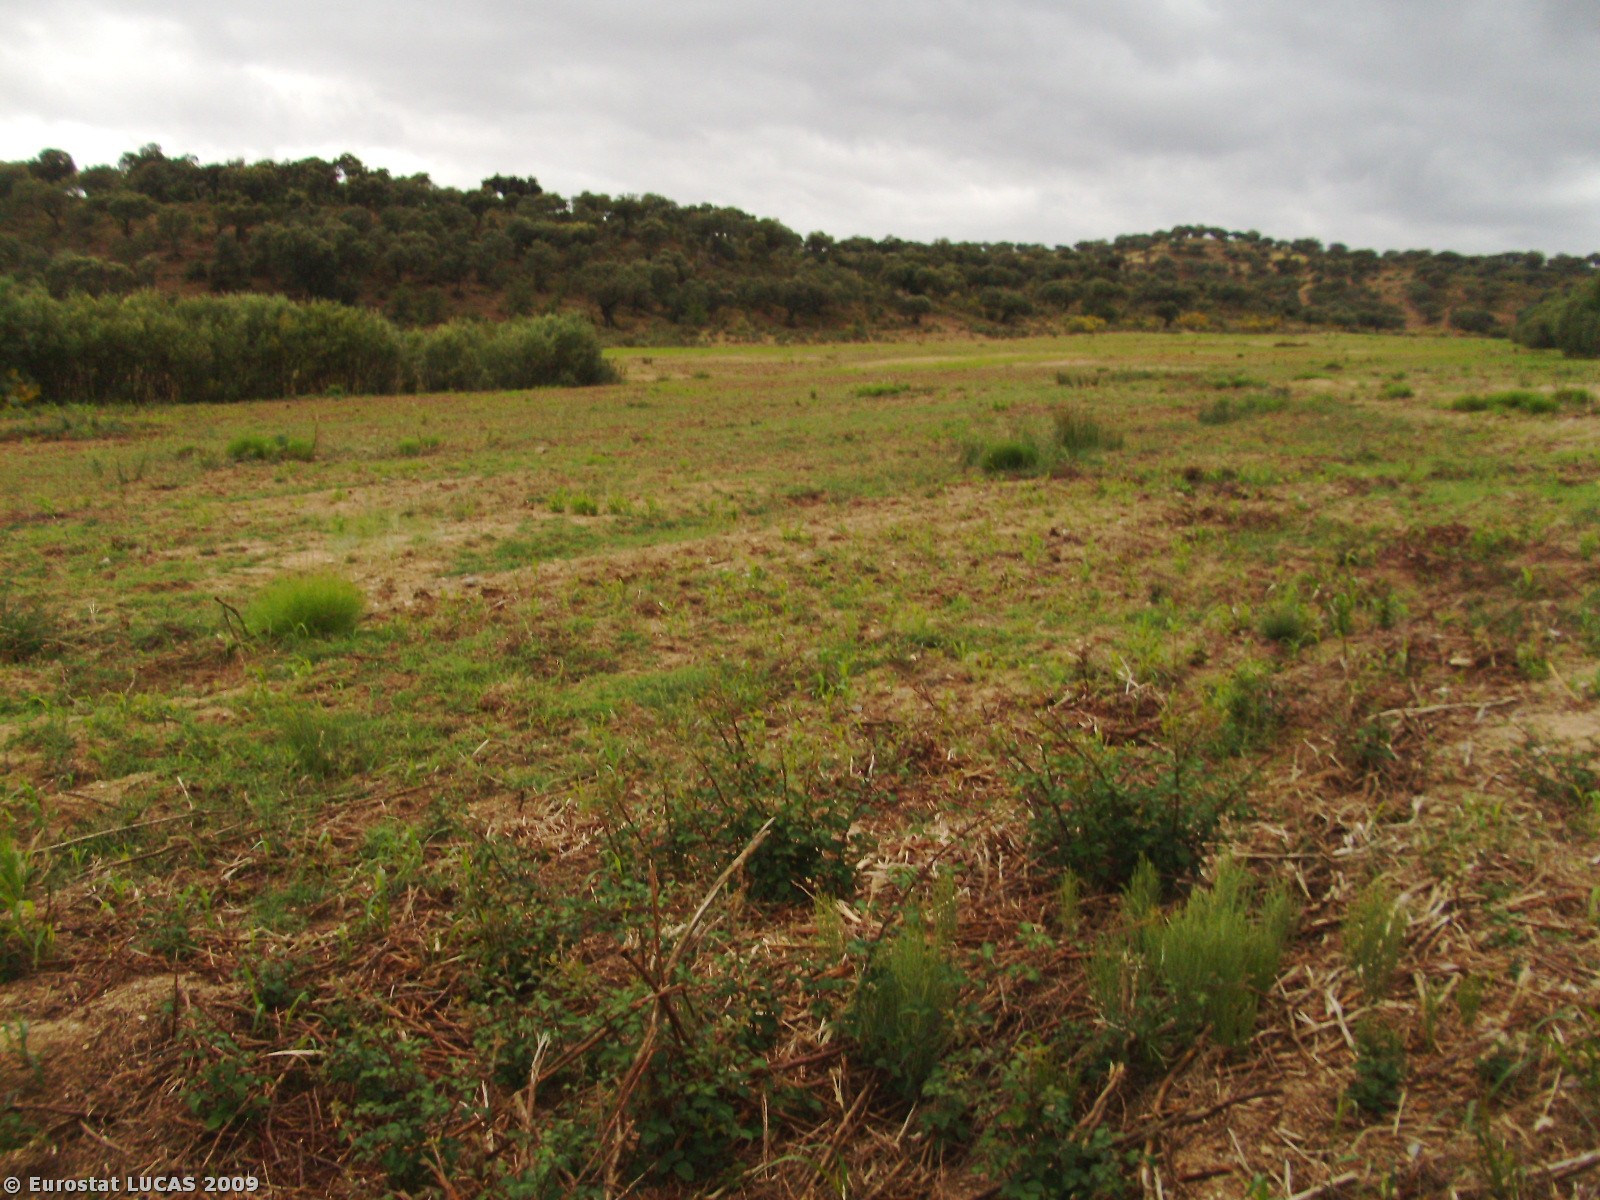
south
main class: Woodland
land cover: Broadleaved woodland
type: mesophytic deciduous forest
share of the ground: > 75 %
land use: Forestry
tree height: > 5 m
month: June
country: PT
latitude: 39.7896
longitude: -7.3904
